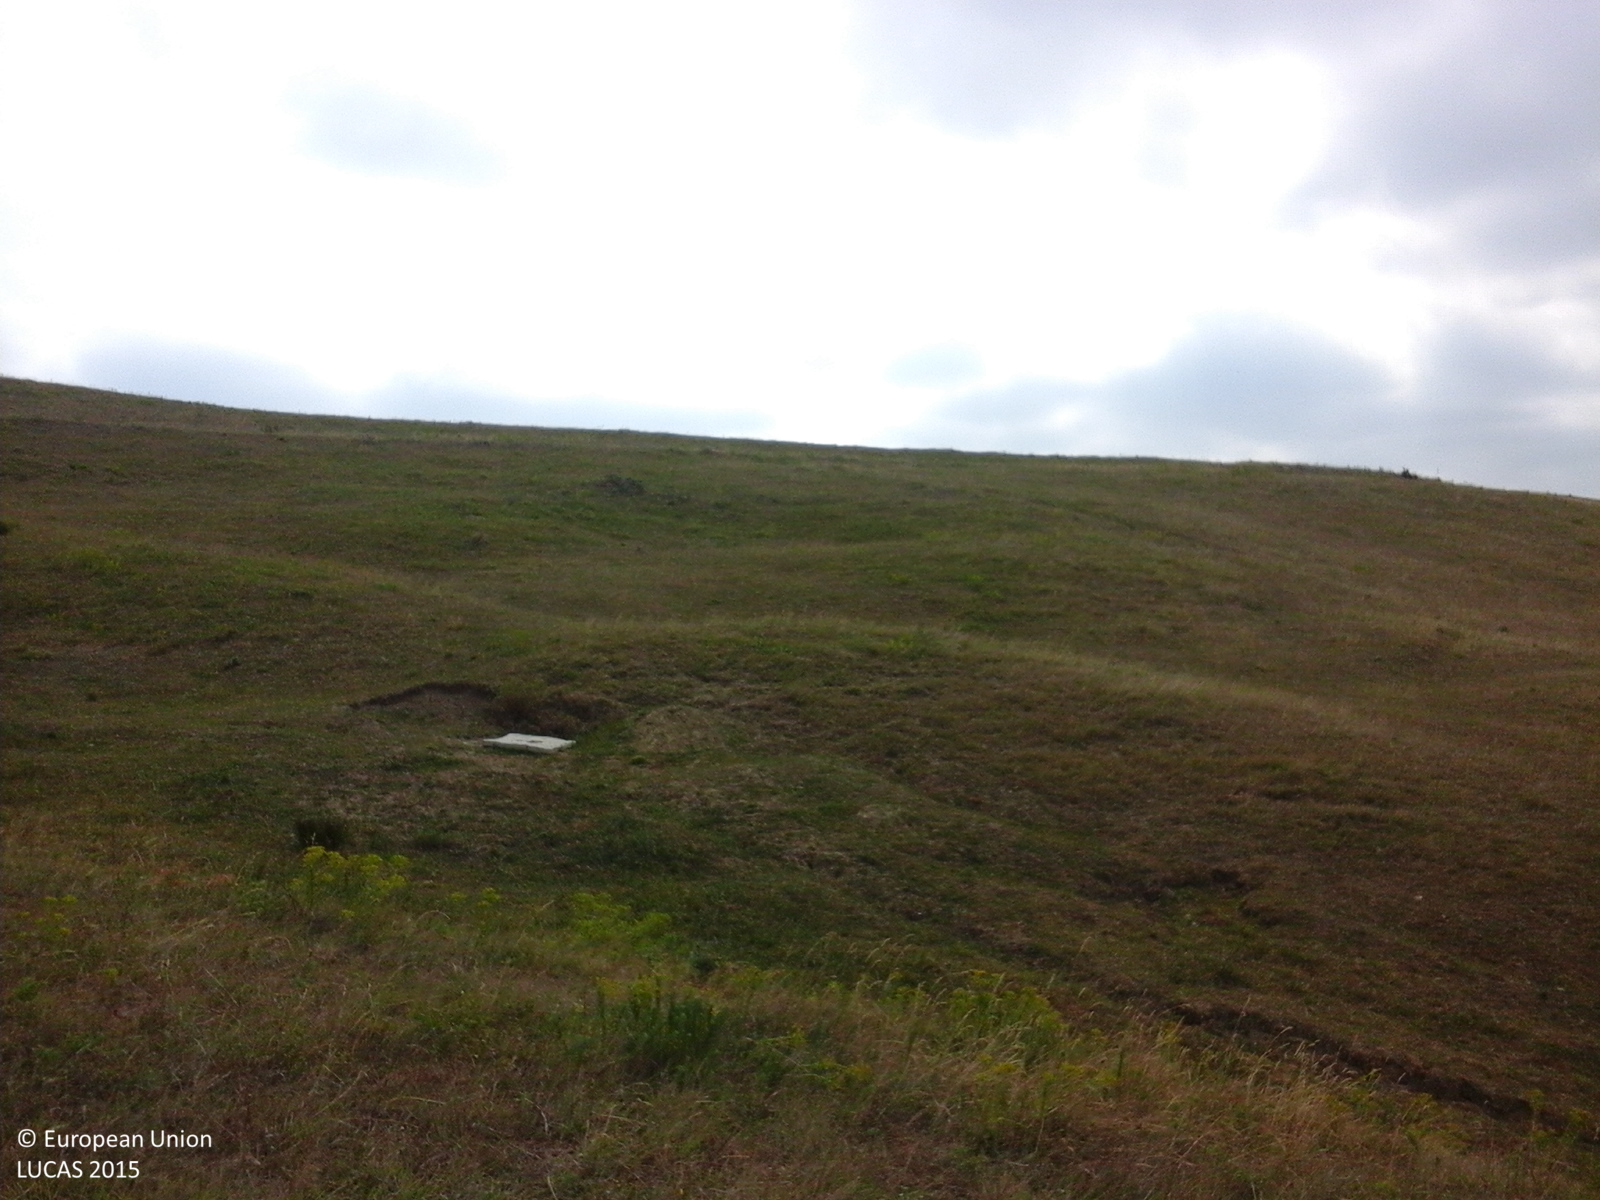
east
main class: Grassland
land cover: Grassland without tree/shrub cover
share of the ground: > 75 %
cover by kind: herbaceous plants 100 %
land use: Agriculture (excluding fallow land and kitchen gardens)
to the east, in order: Grassland without tree/shrub cover; Lucerne; Other leguminous and mixtures for fodder; Tracks; Other leguminous and mixtures for fodder
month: June
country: RO
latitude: 47.6531
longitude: 26.5882
